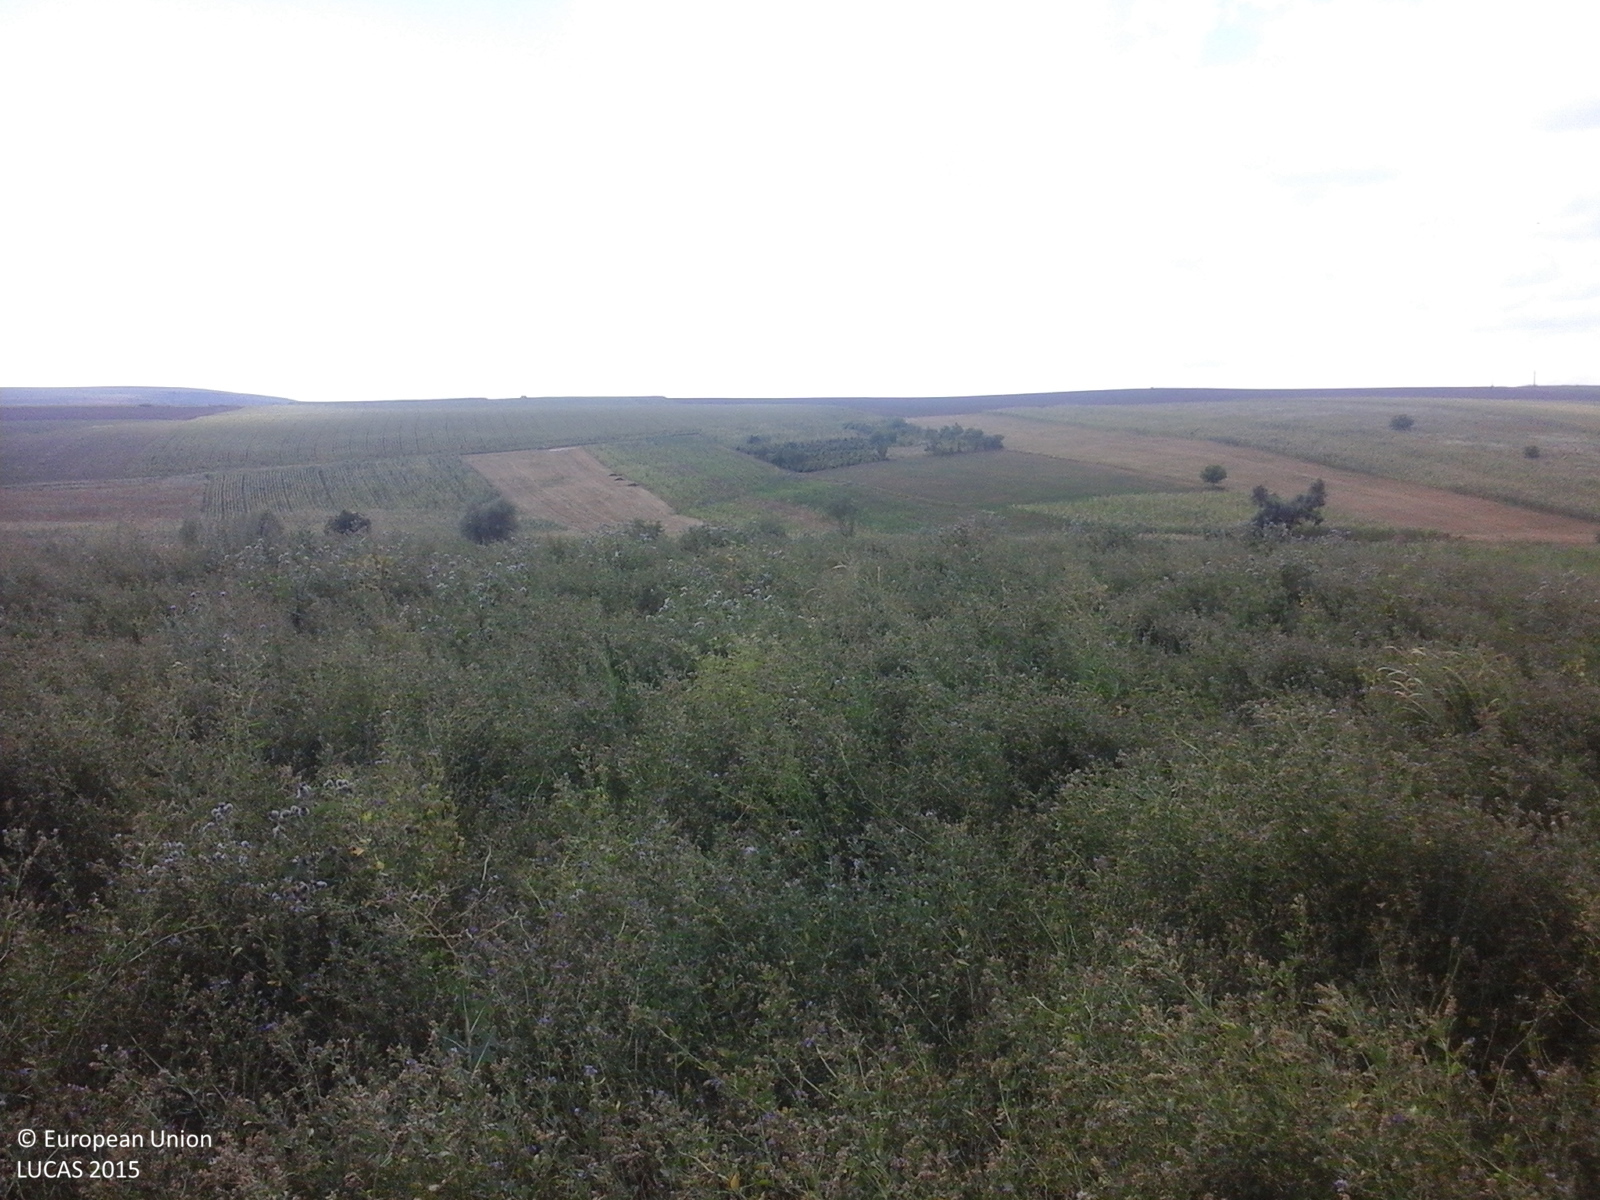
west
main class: Cropland
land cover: Lucerne
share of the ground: > 75 %
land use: Agriculture (excluding fallow land and kitchen gardens)
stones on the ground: < 10 %
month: July
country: RO
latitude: 46.5859
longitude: 27.4007
